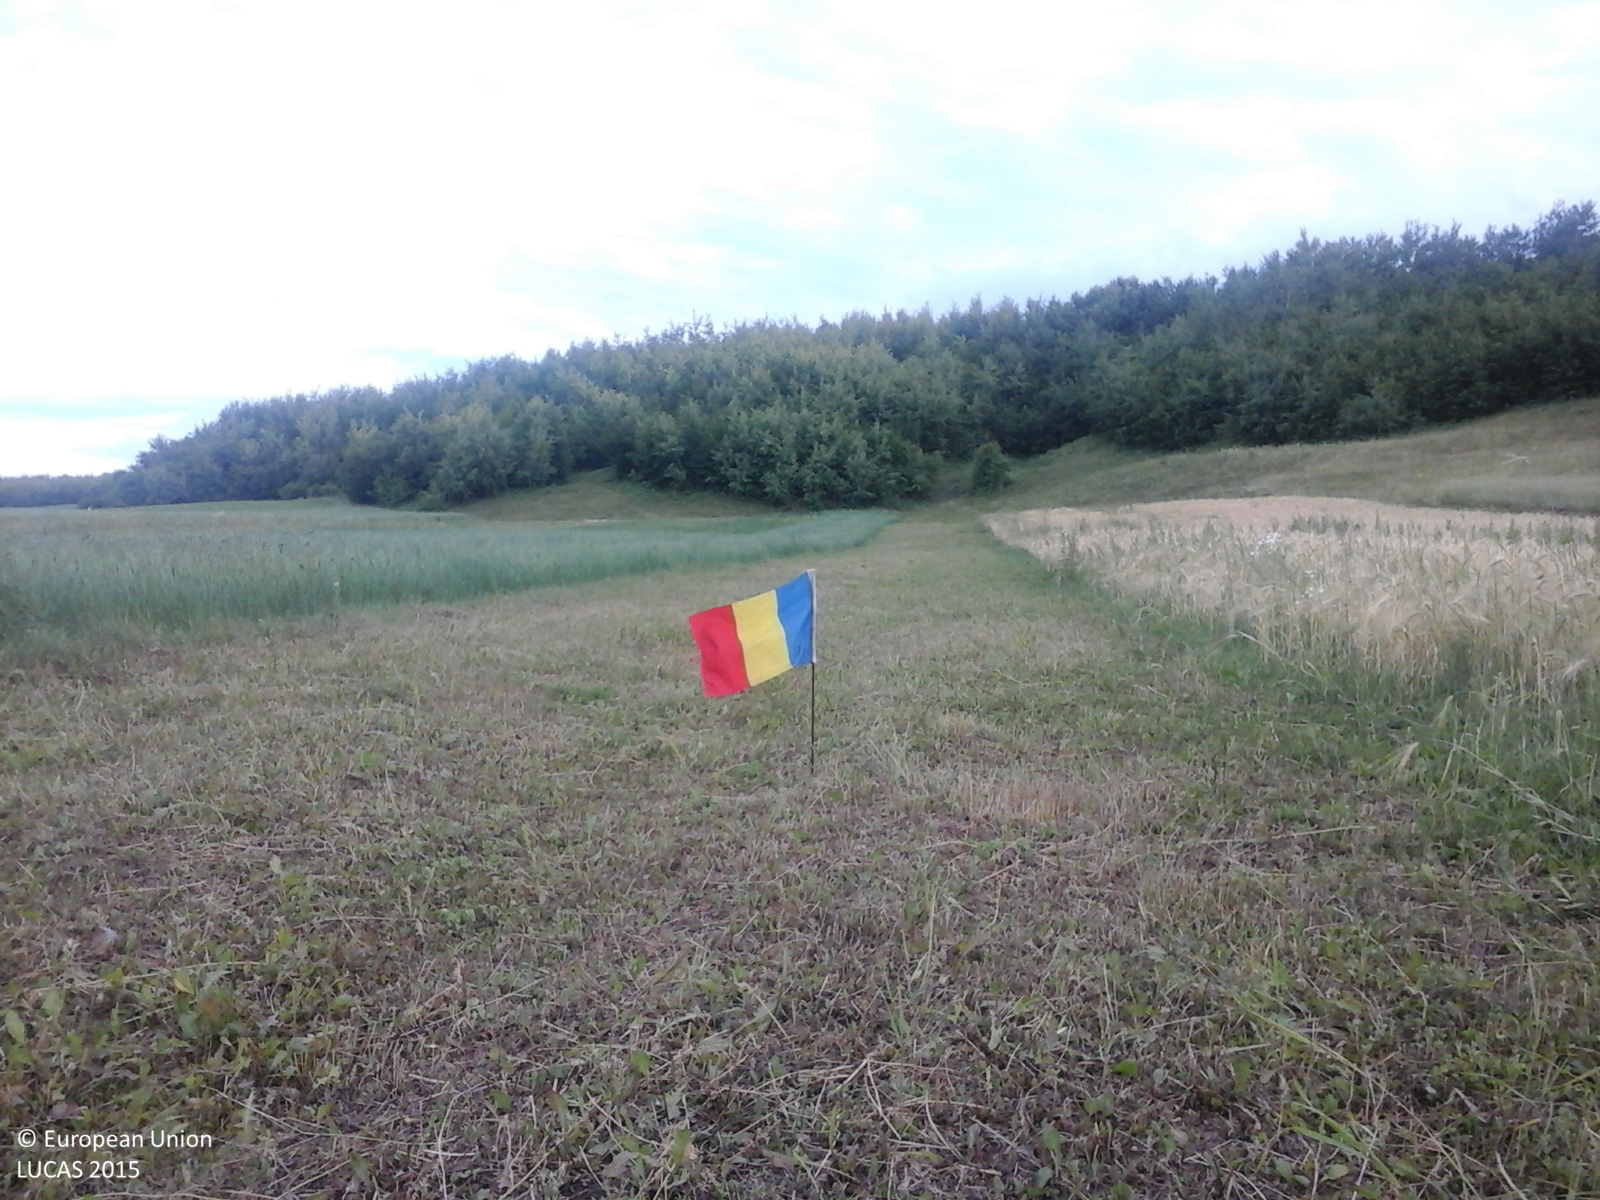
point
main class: Cropland
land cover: Lucerne
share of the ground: > 75 %
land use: Agriculture (excluding fallow land and kitchen gardens)
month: June
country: RO
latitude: 47.4822
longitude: 26.5048
